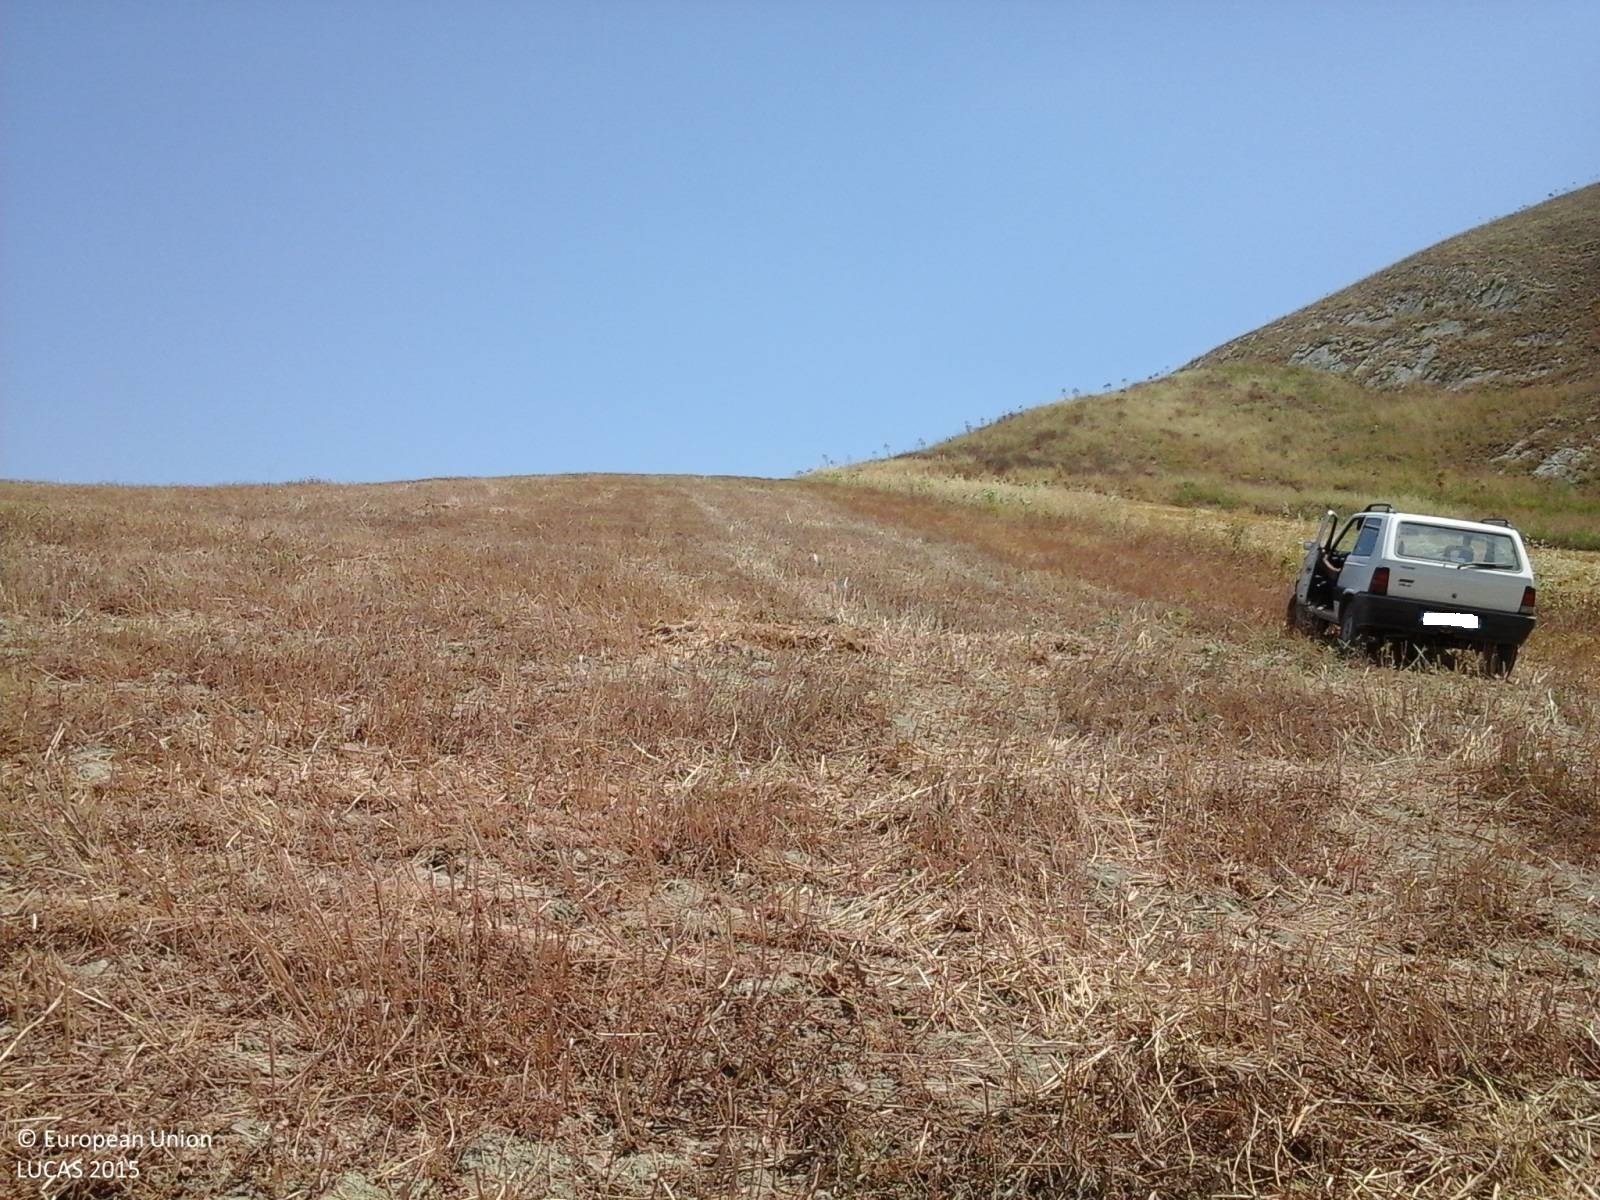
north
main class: Cropland
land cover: Other leguminous and mixtures for fodder
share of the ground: > 75 %
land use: Agriculture (excluding fallow land and kitchen gardens)
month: July
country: IT
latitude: 37.8053
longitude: 13.1232
